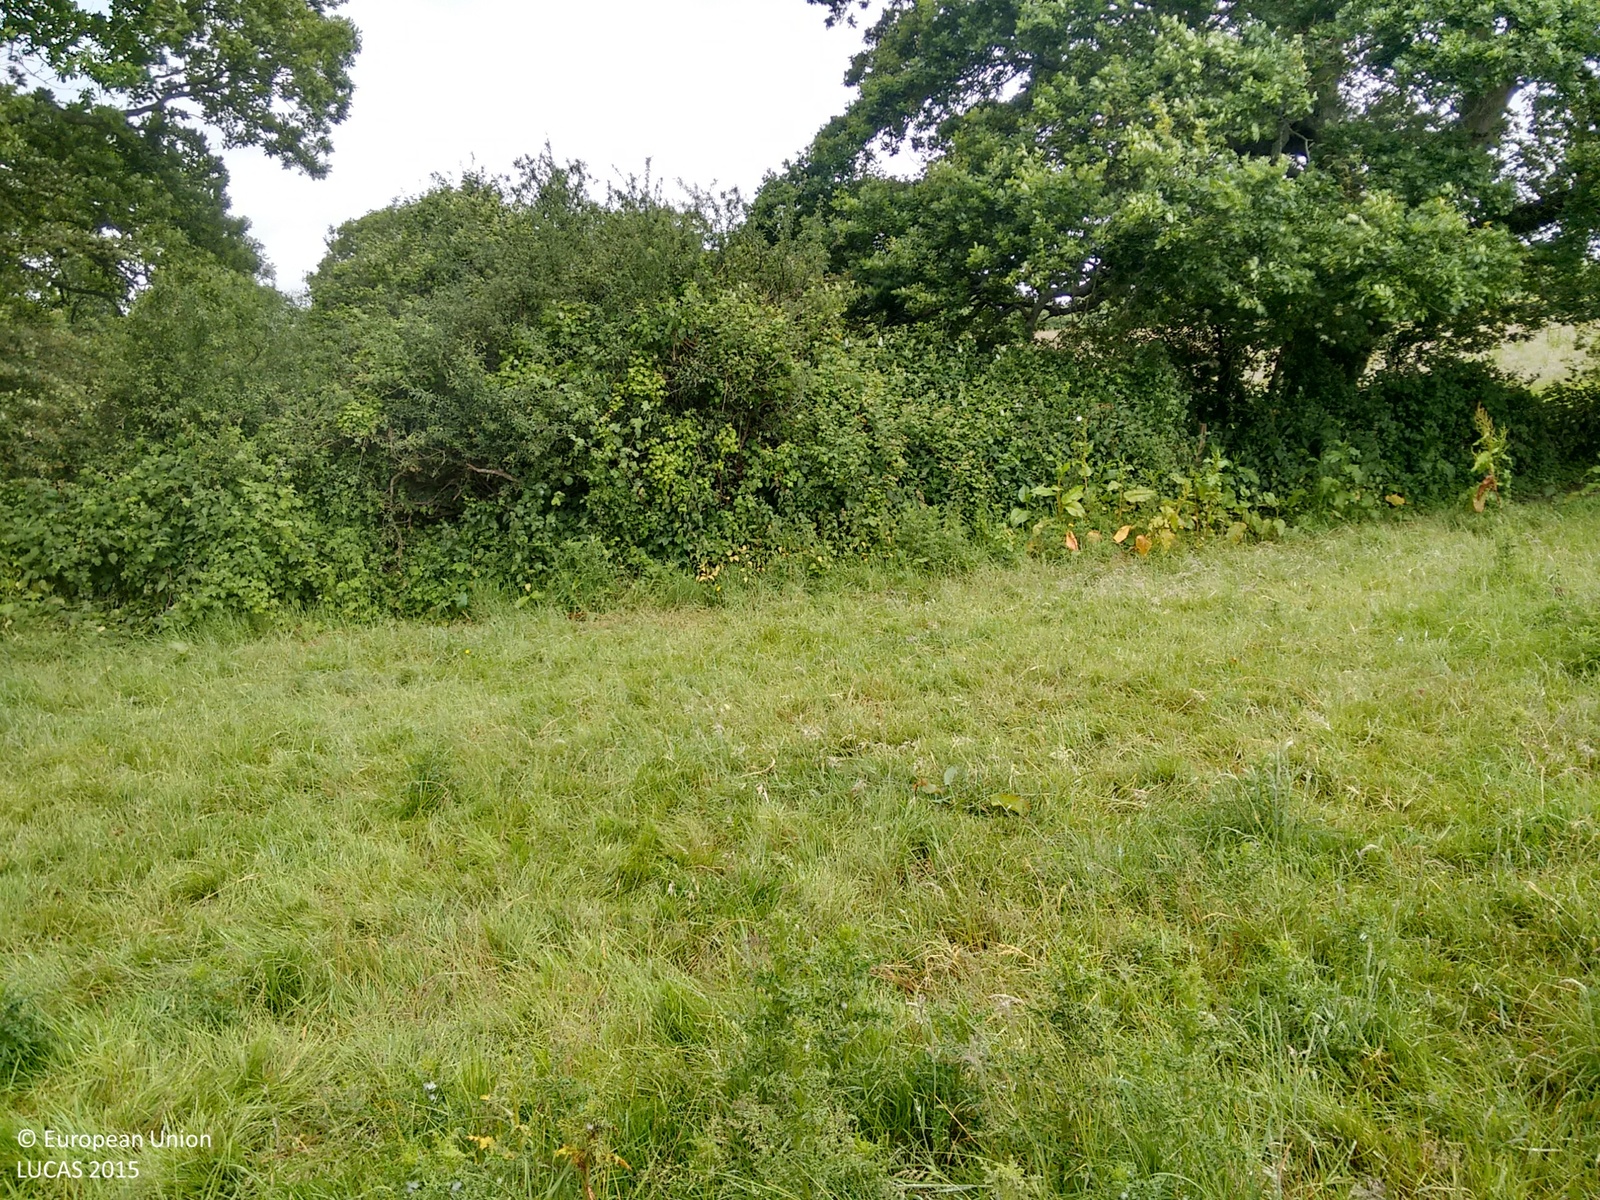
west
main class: Grassland
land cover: Grassland without tree/shrub cover
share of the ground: > 75 %
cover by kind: herbaceous plants 100 %
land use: Agriculture (excluding fallow land and kitchen gardens)
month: June
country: GB
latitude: 50.9902
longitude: 0.3830
